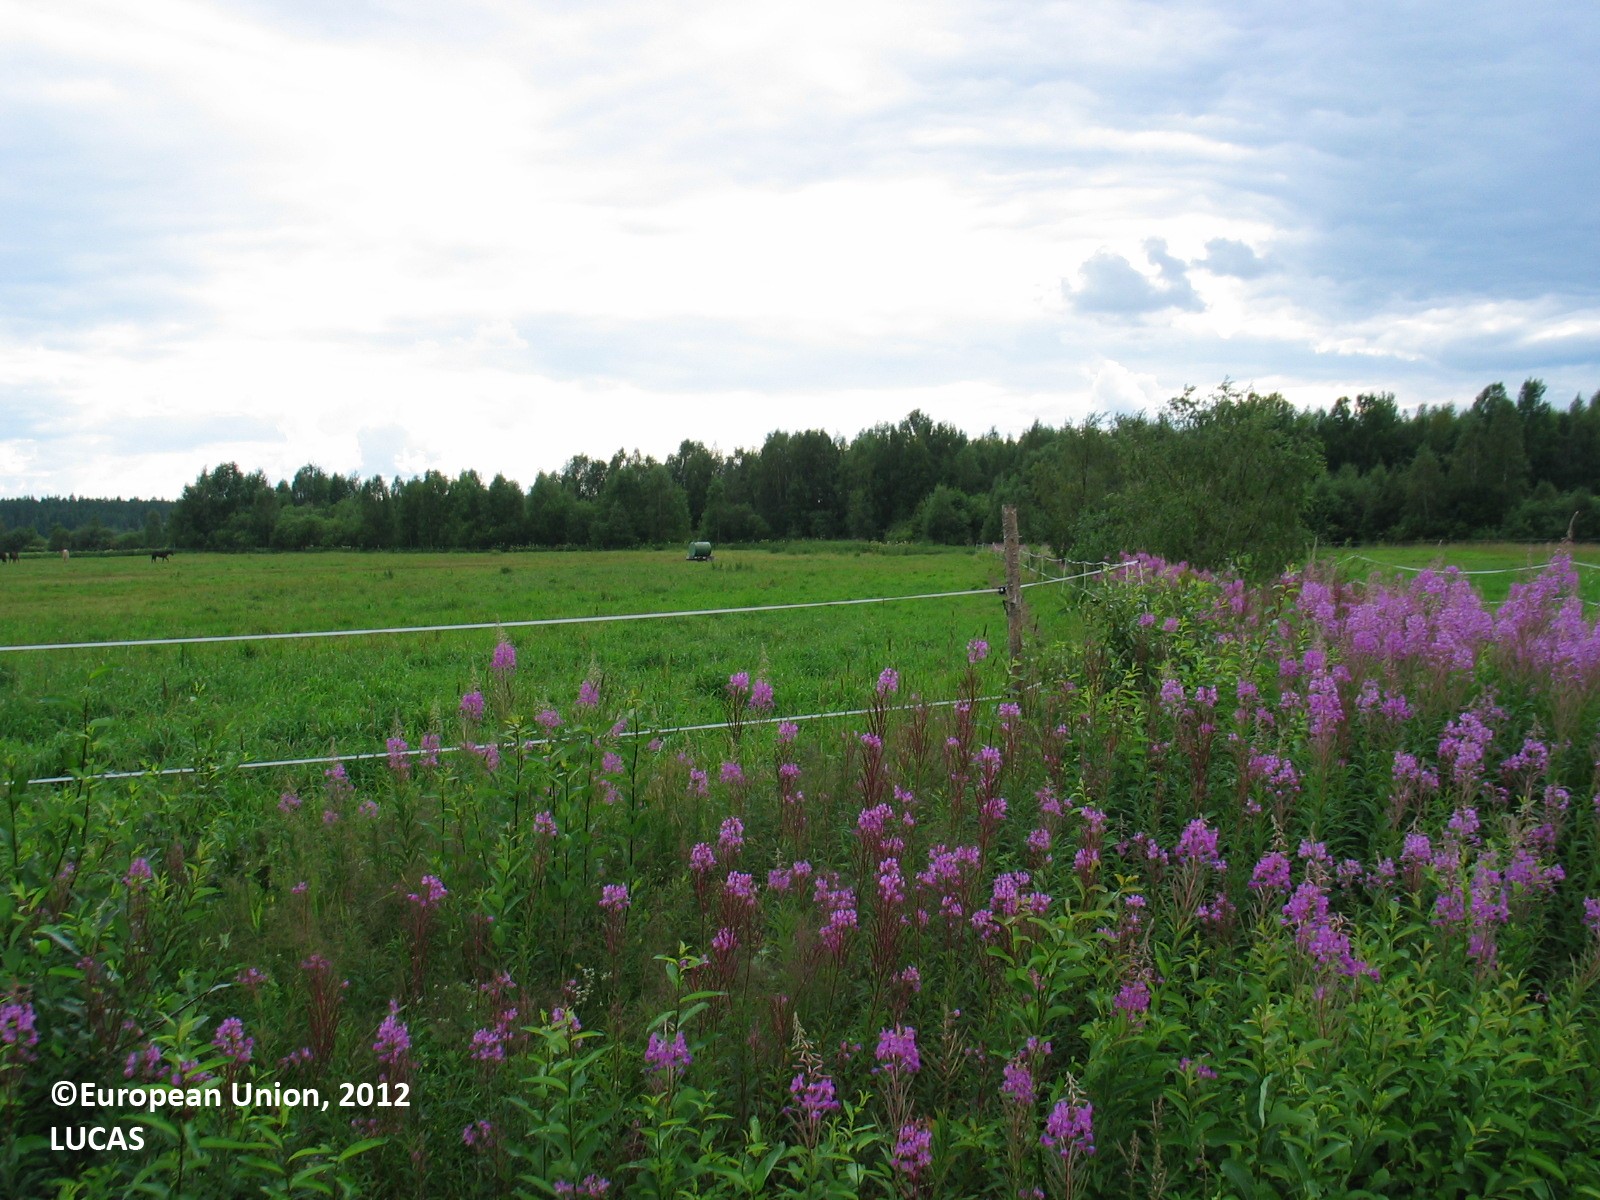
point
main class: Grassland
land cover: Grassland without tree/shrub cover
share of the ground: > 75 %
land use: Agriculture (excluding fallow land and kitchen gardens)
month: July
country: FI
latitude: 64.7676
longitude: 26.1435
